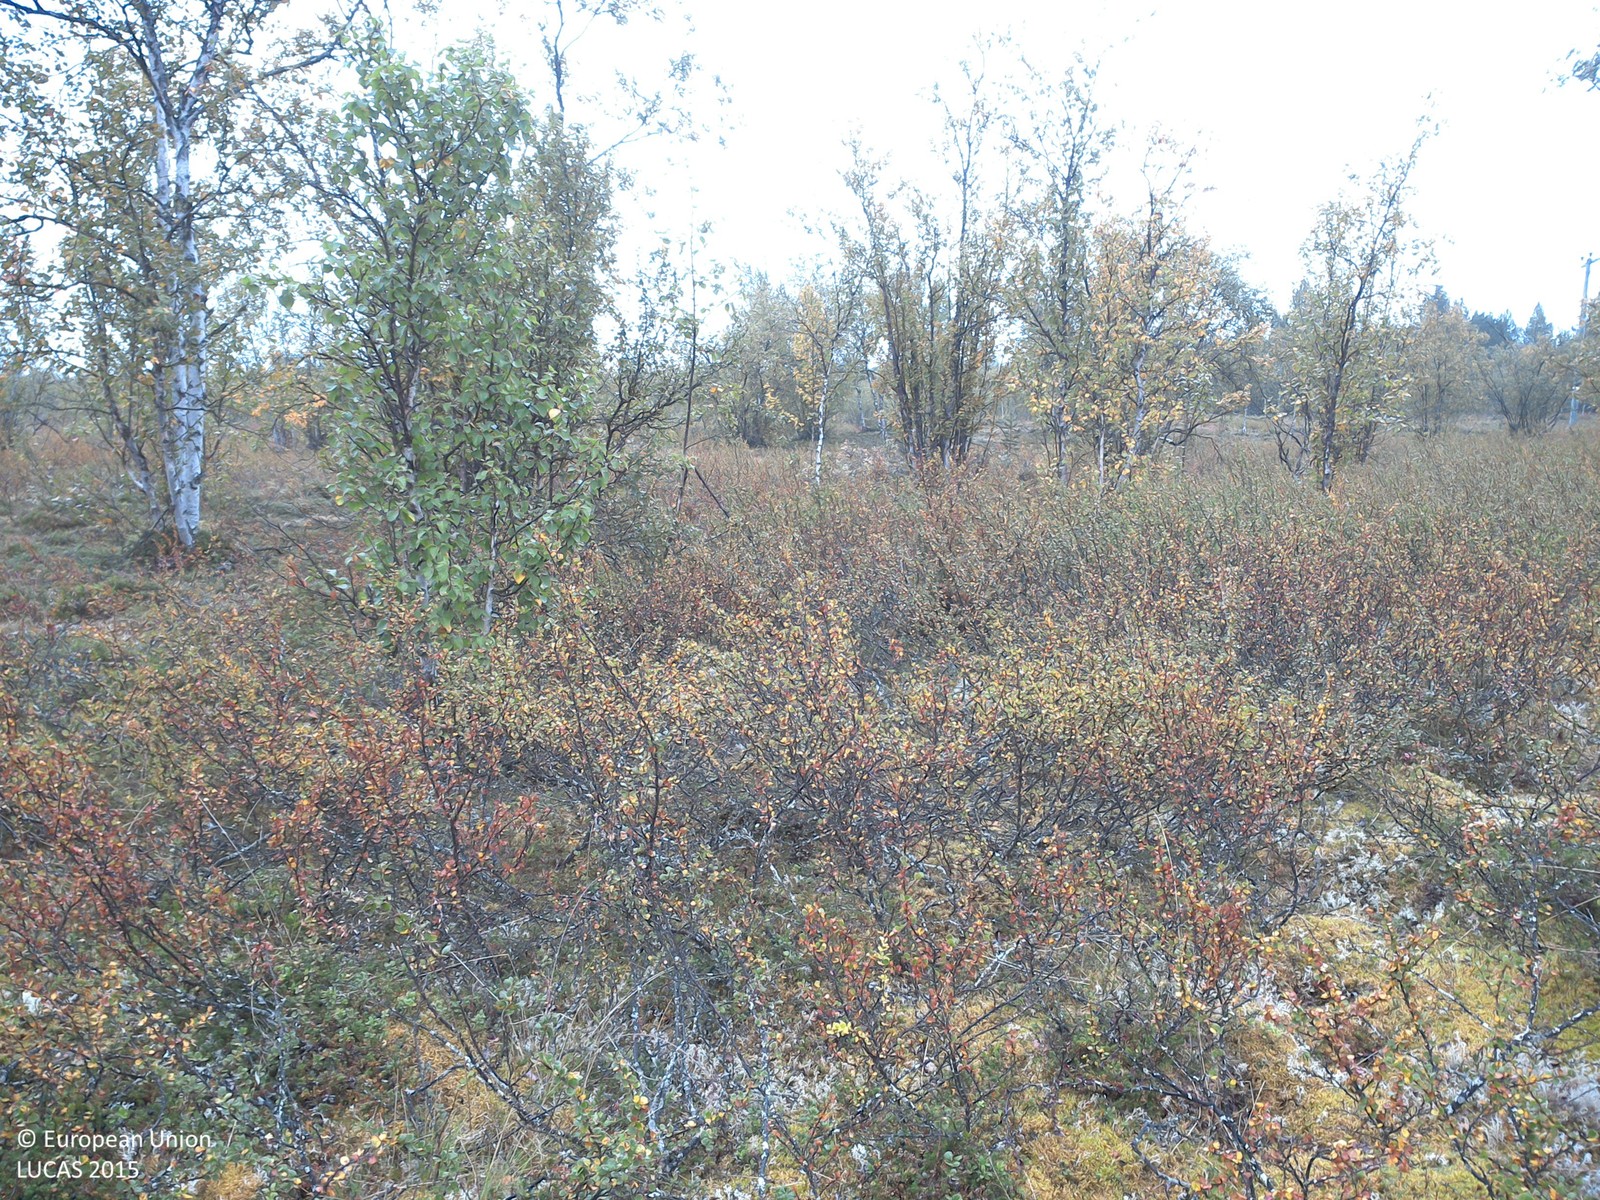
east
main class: Woodland
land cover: Broadleaved woodland
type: boreal forest
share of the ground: 10 - 25 %
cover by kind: shrubs 55 %, lichens and mosses 25 %, broadleaved forest trees 20 %
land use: Amenities, museums, leisure
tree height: > 5 m
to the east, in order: Broadleaved woodland; Electric lines; Shrubland with sparse tree cover; Broadleaved woodland
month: August
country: SE
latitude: 68.1913
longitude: 21.8335
